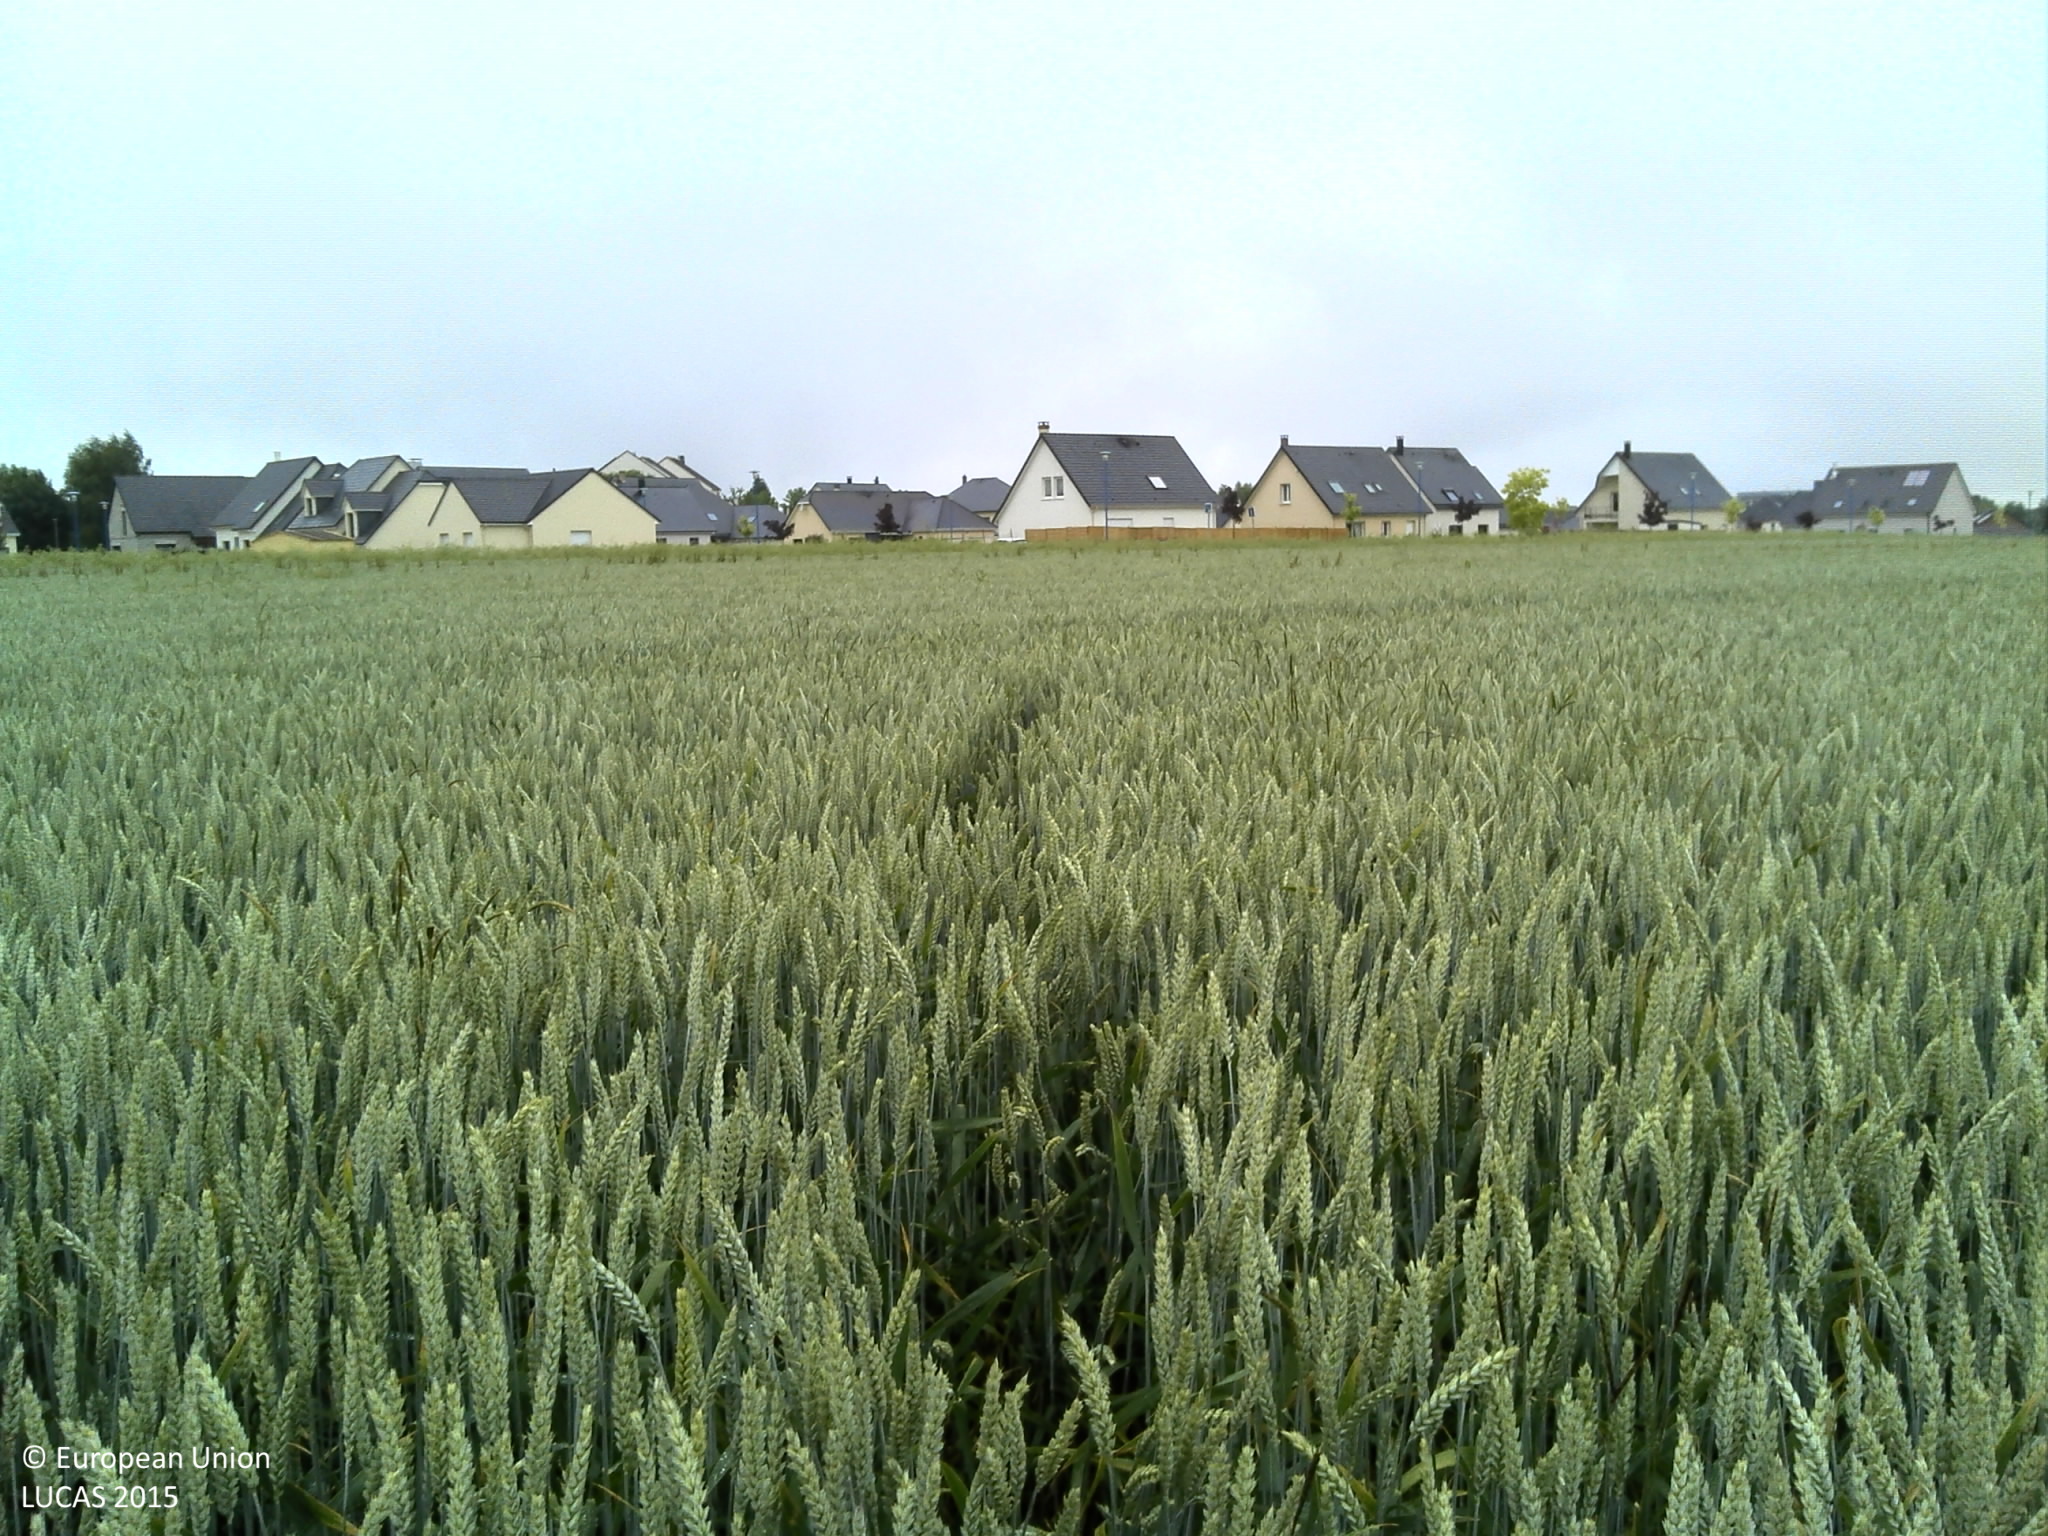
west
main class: Cropland
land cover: Common wheat
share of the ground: > 75 %
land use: Agriculture (excluding fallow land and kitchen gardens)
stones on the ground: 10 - 25 %
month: June
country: FR
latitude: 49.4228
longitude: 1.1419
